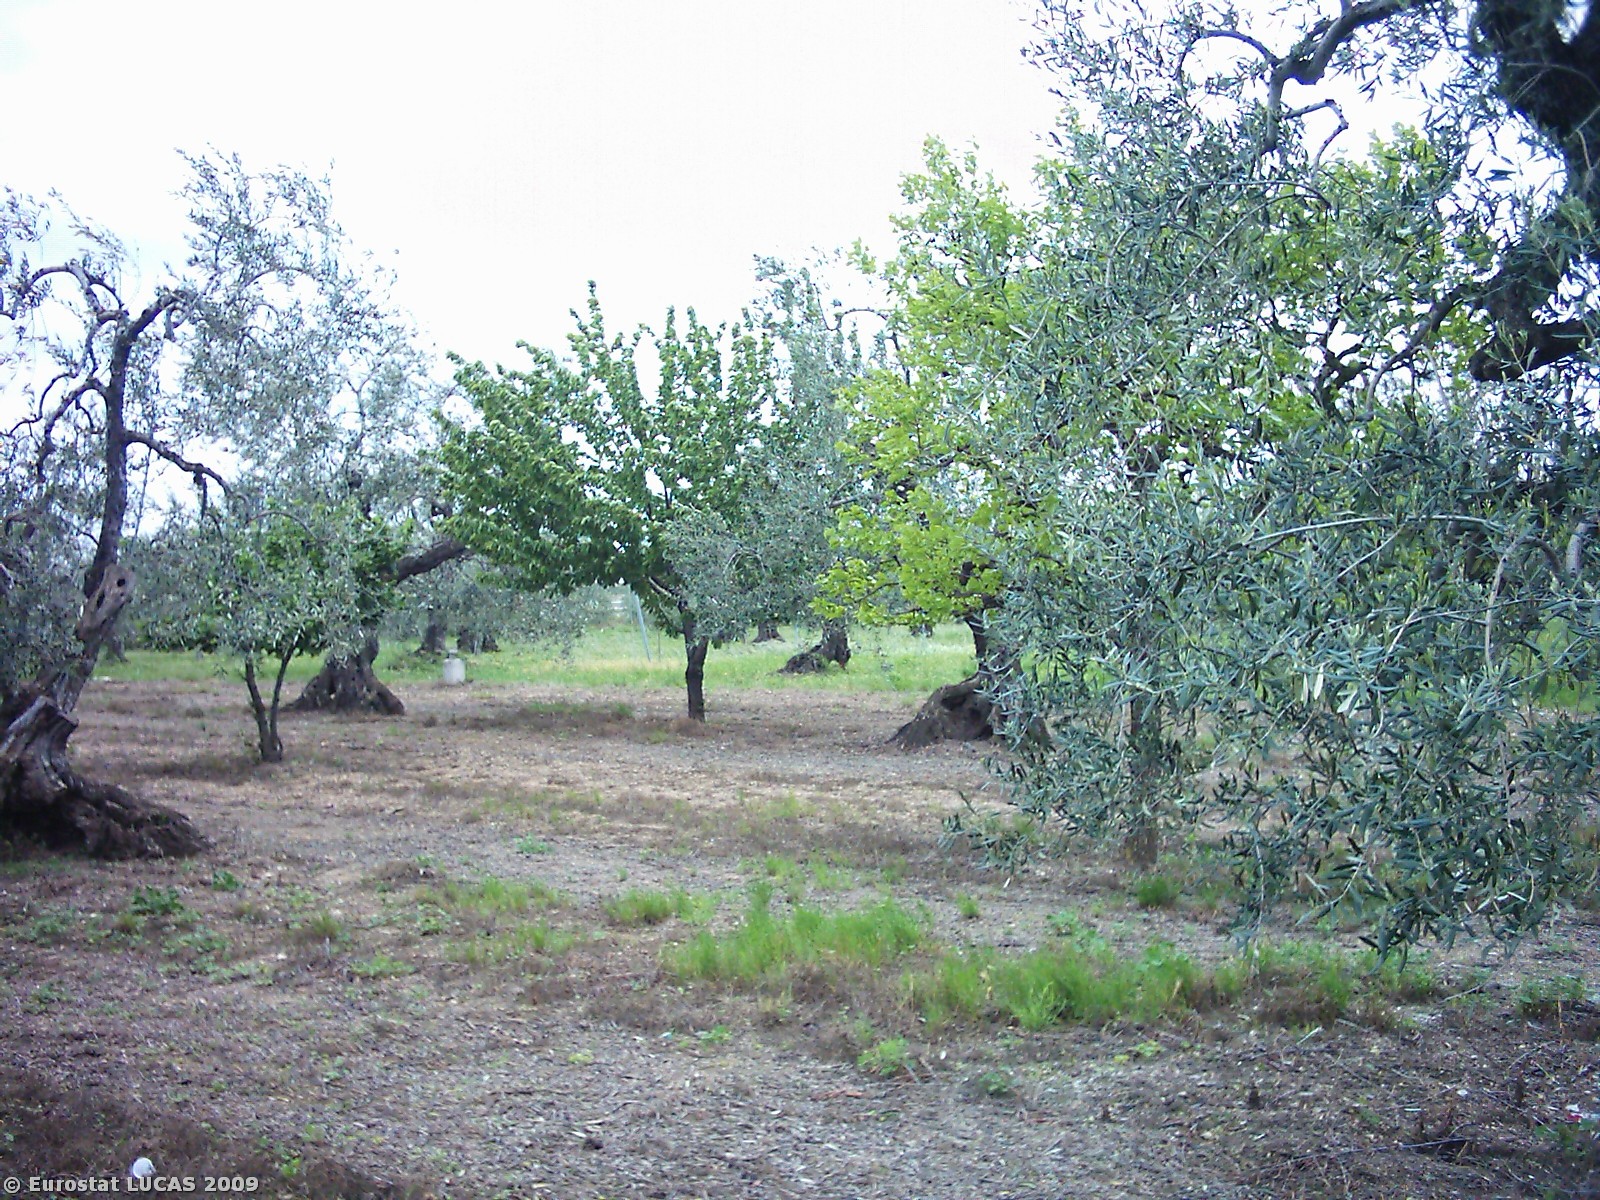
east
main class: Cropland
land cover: Olive groves
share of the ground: 10 - 25 %
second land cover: Bare land
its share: > 75 %
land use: Agriculture (excluding fallow land and kitchen gardens)
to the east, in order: Olive groves; Bare land; Tracks; Olive groves; Other fruit trees and berries; Olive groves; Grass margins; Paved roads, cycling and walking lanes; Artificial constructions; Paved roads, cycling and walking lanes; Artificial constructions; Paved roads, cycling and walking lanes; Artificial constructions; Paved roads, cycling and walking lanes; Grassland without tree/shrub cover
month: April
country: IT
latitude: 41.1857
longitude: 16.3581
